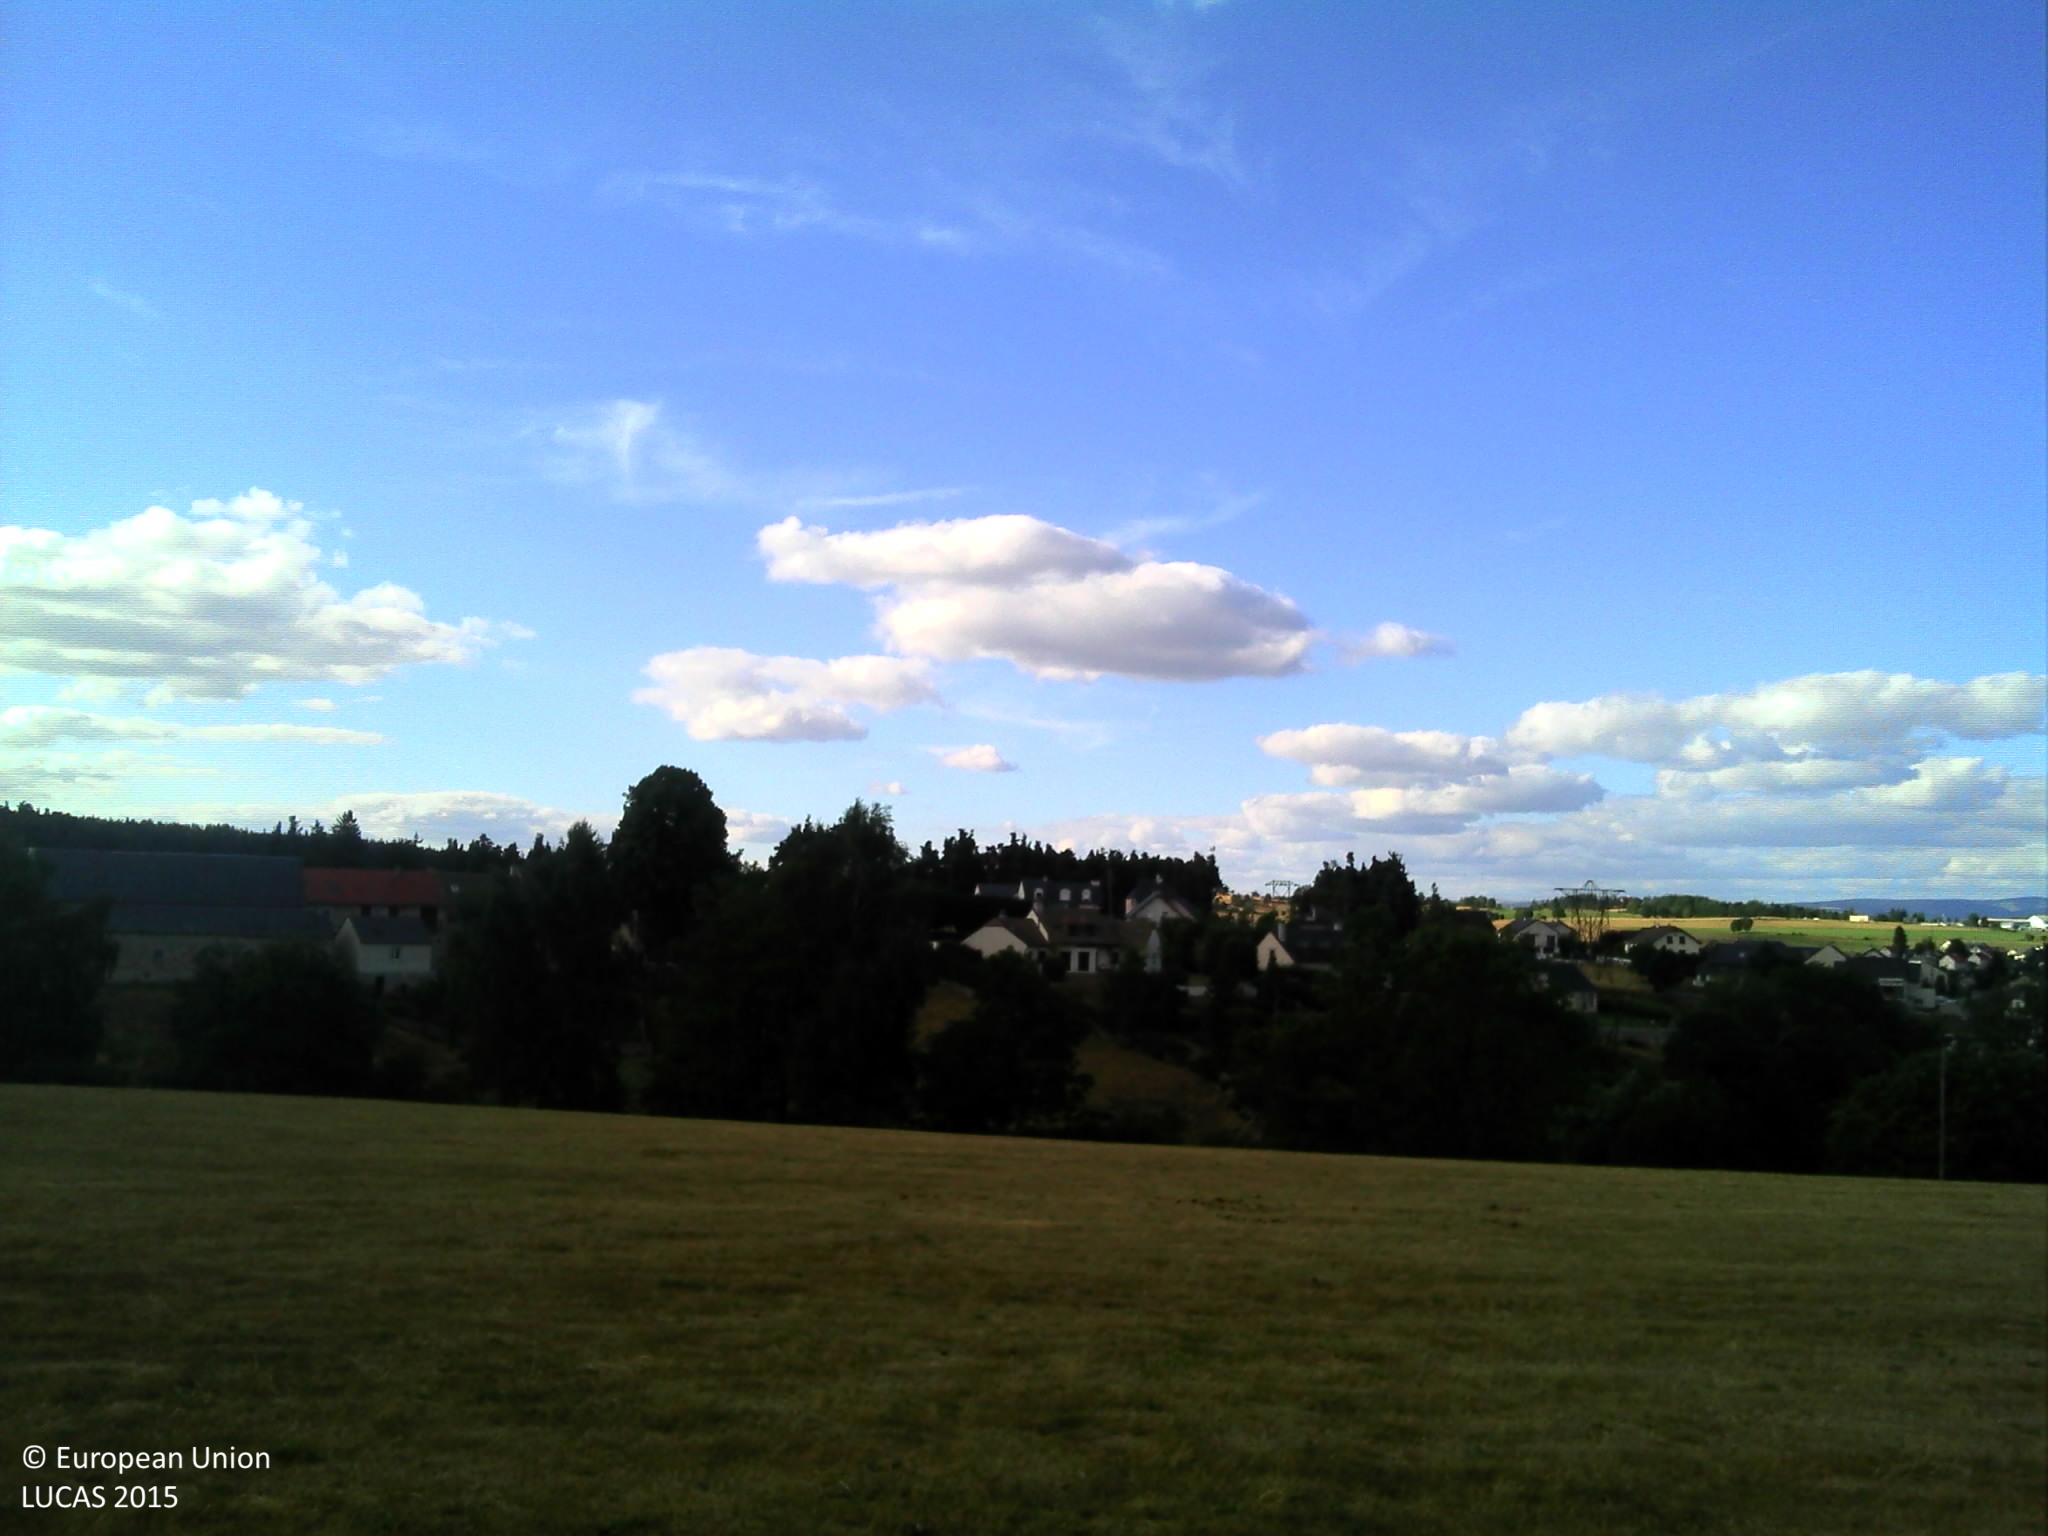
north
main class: Grassland
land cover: Grassland without tree/shrub cover
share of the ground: > 75 %
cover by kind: herbaceous plants 95 %, shrubs 5 %
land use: Agriculture (excluding fallow land and kitchen gardens)
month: July
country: FR
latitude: 44.8010
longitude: 3.2653
